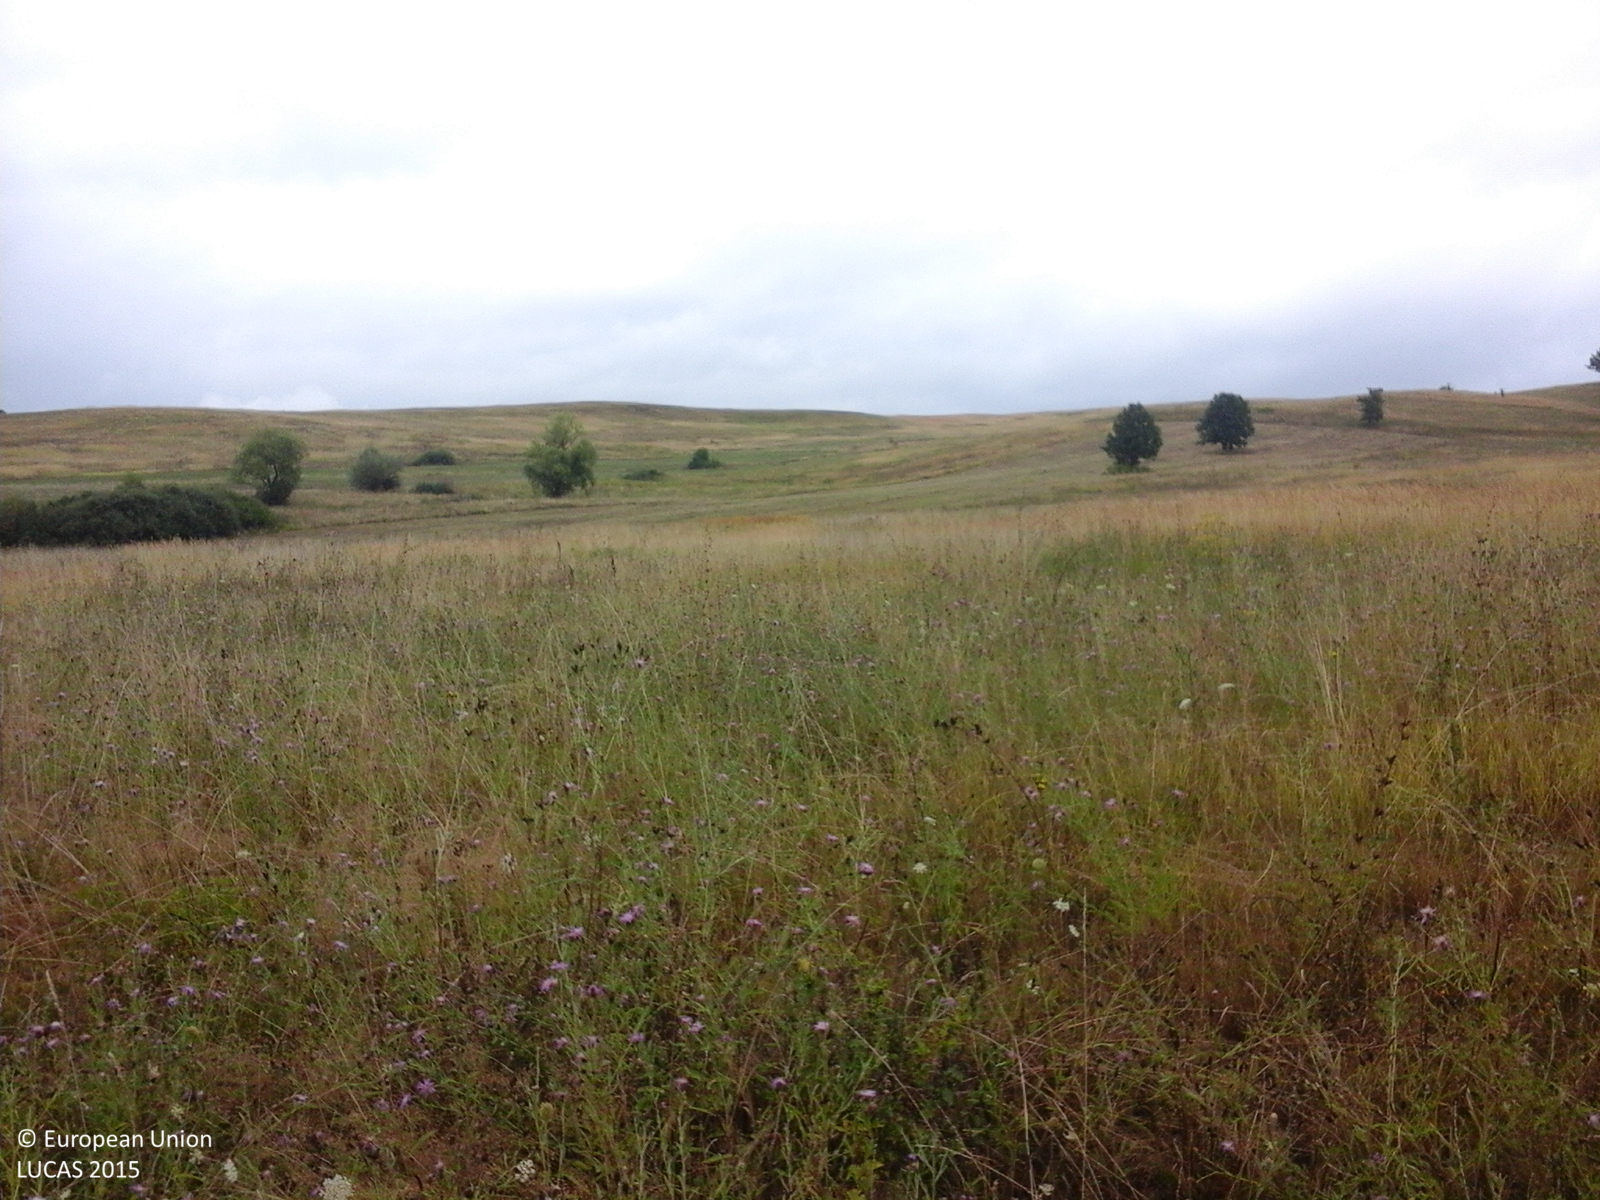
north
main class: Grassland
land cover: Grassland without tree/shrub cover
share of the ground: > 75 %
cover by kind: herbaceous plants 100 %
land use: Agriculture (excluding fallow land and kitchen gardens)
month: August
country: RO
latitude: 44.8694
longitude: 22.0210
